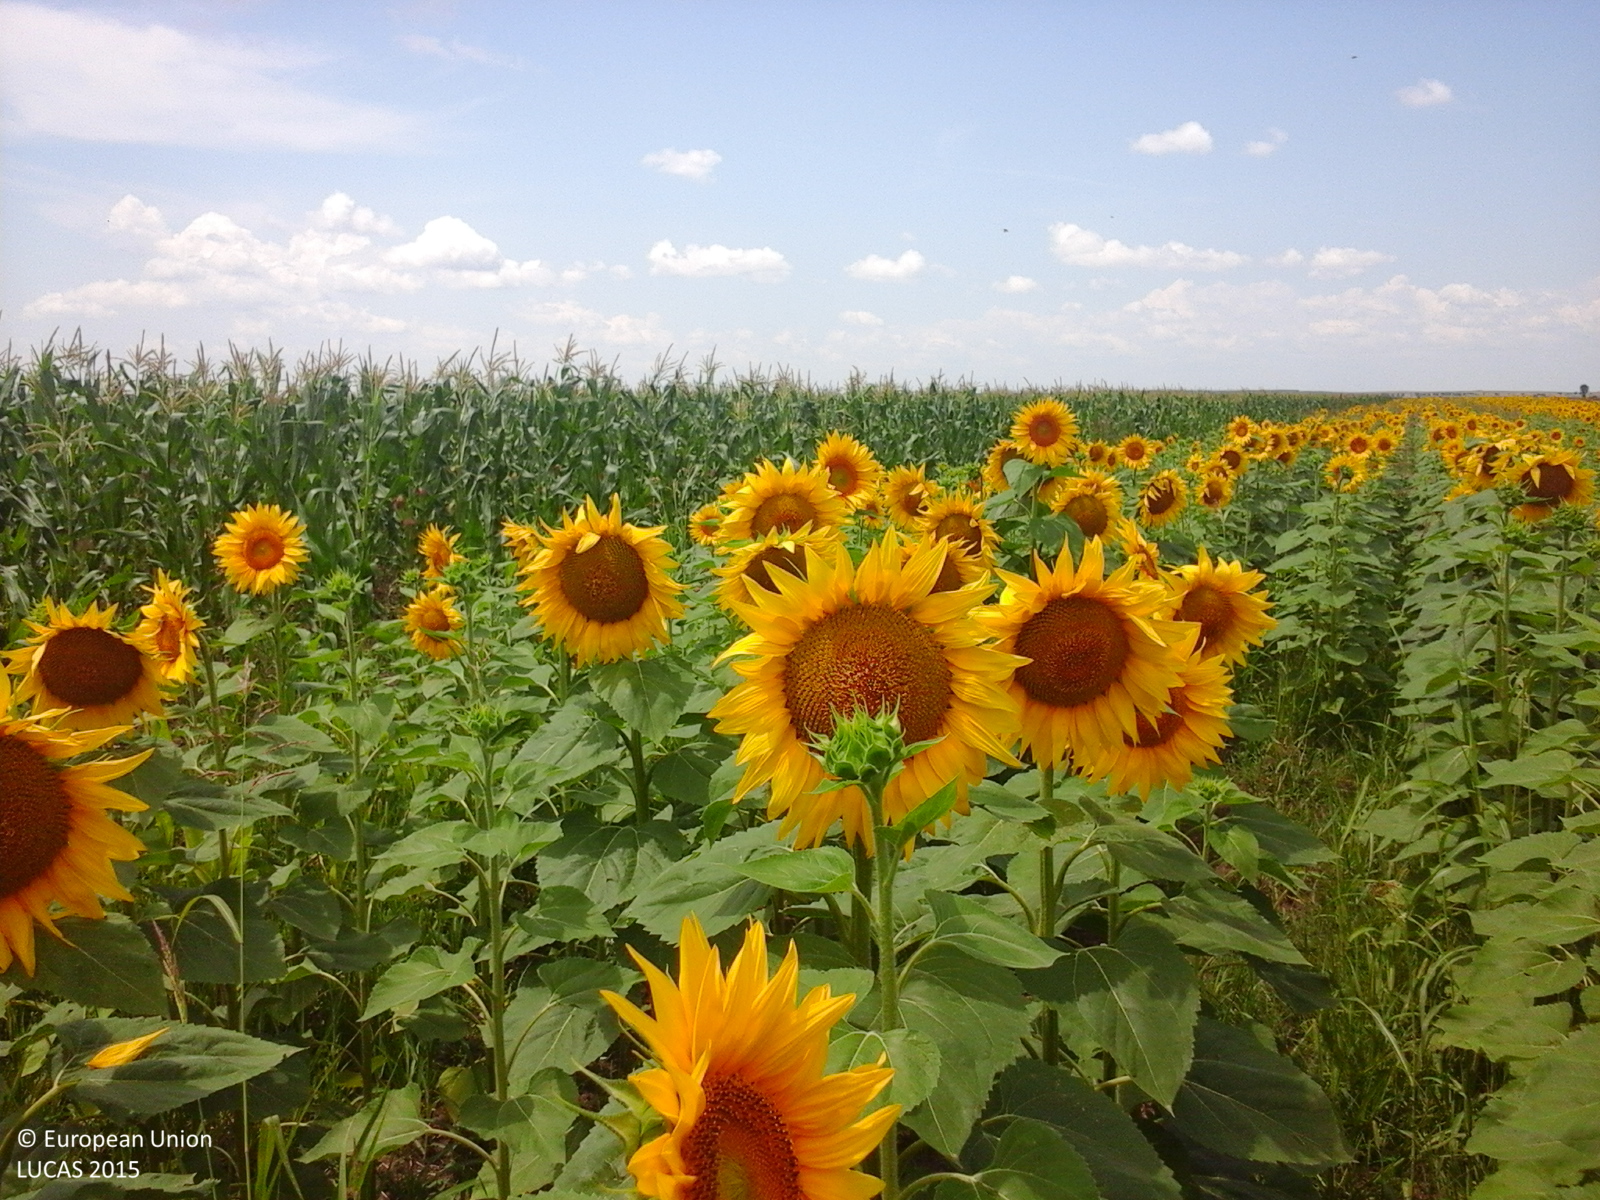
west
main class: Cropland
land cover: Sunflower
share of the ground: > 75 %
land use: Agriculture (excluding fallow land and kitchen gardens)
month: July
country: RO
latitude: 44.0070
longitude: 24.4716
